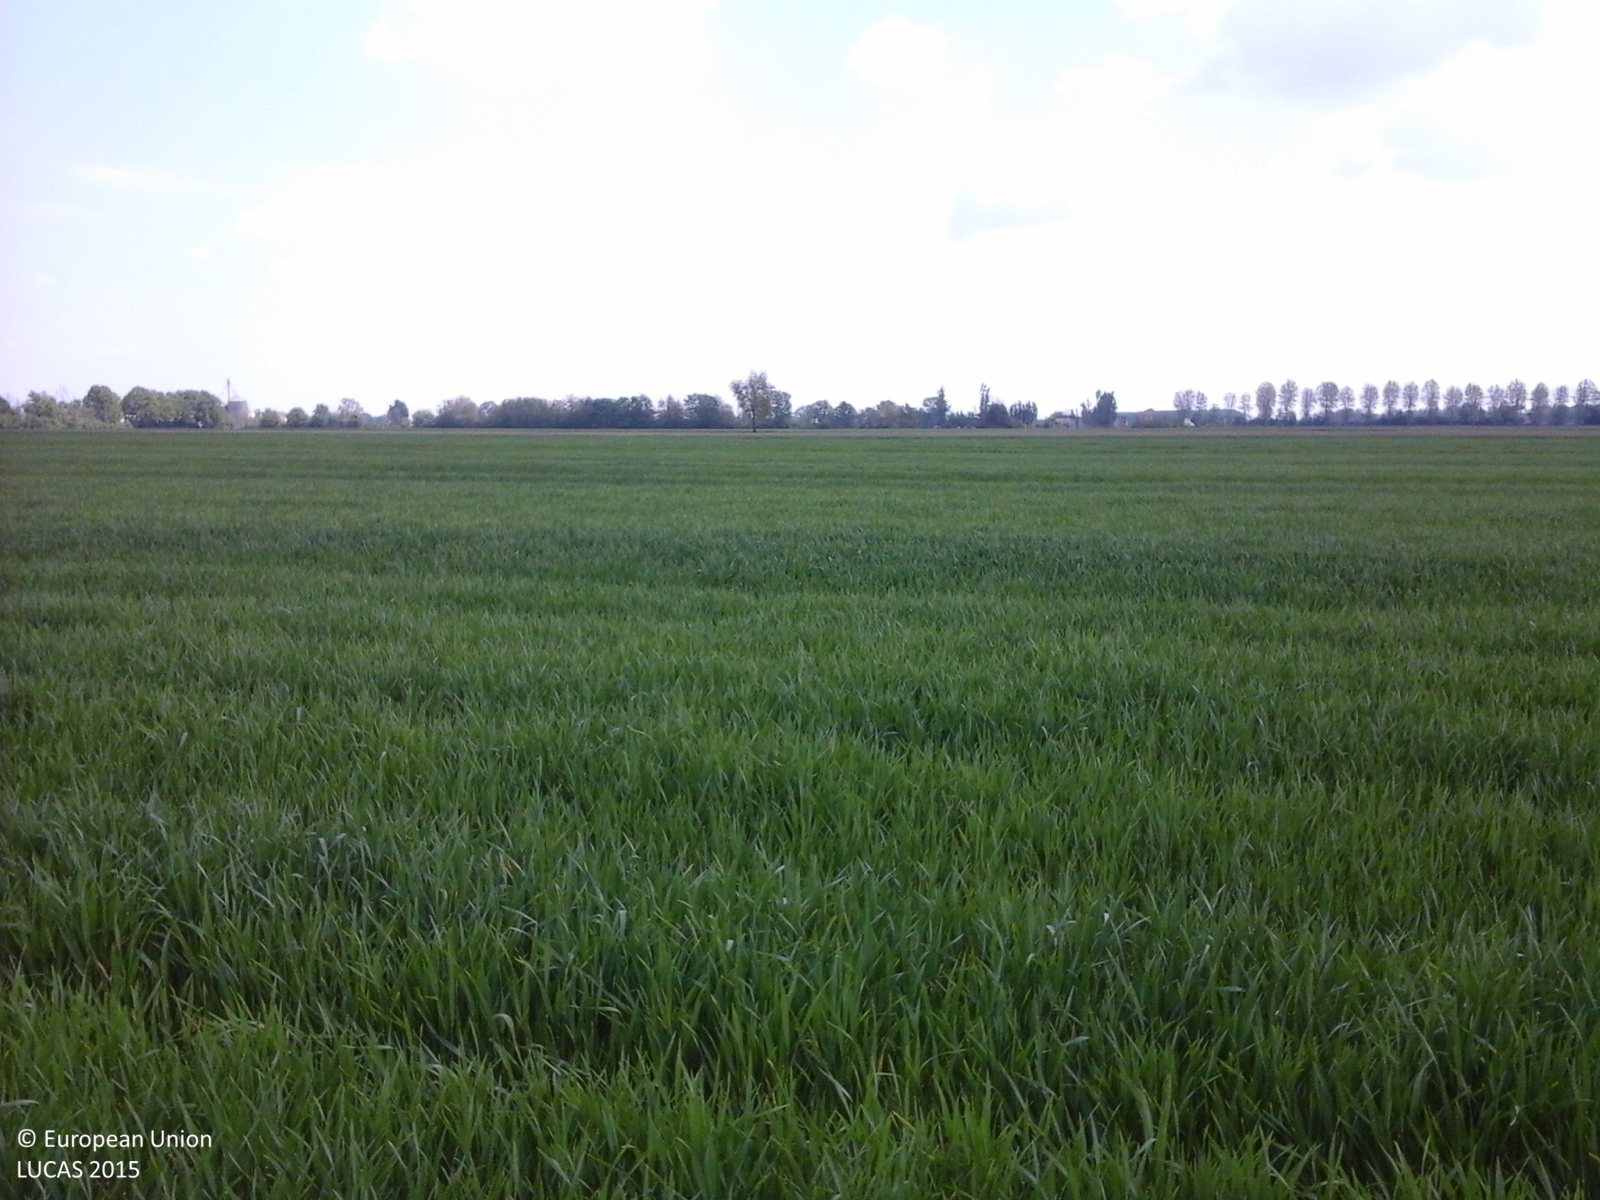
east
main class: Cropland
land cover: Common wheat
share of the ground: > 75 %
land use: Agriculture (excluding fallow land and kitchen gardens)
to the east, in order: Common wheat; Ditches and canals; Common wheat; Ditches and canals; Common wheat; Ditches and canals; Common wheat; Ditches and canals; Other bare soil
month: April
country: IT
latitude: 44.9057
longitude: 10.8974
